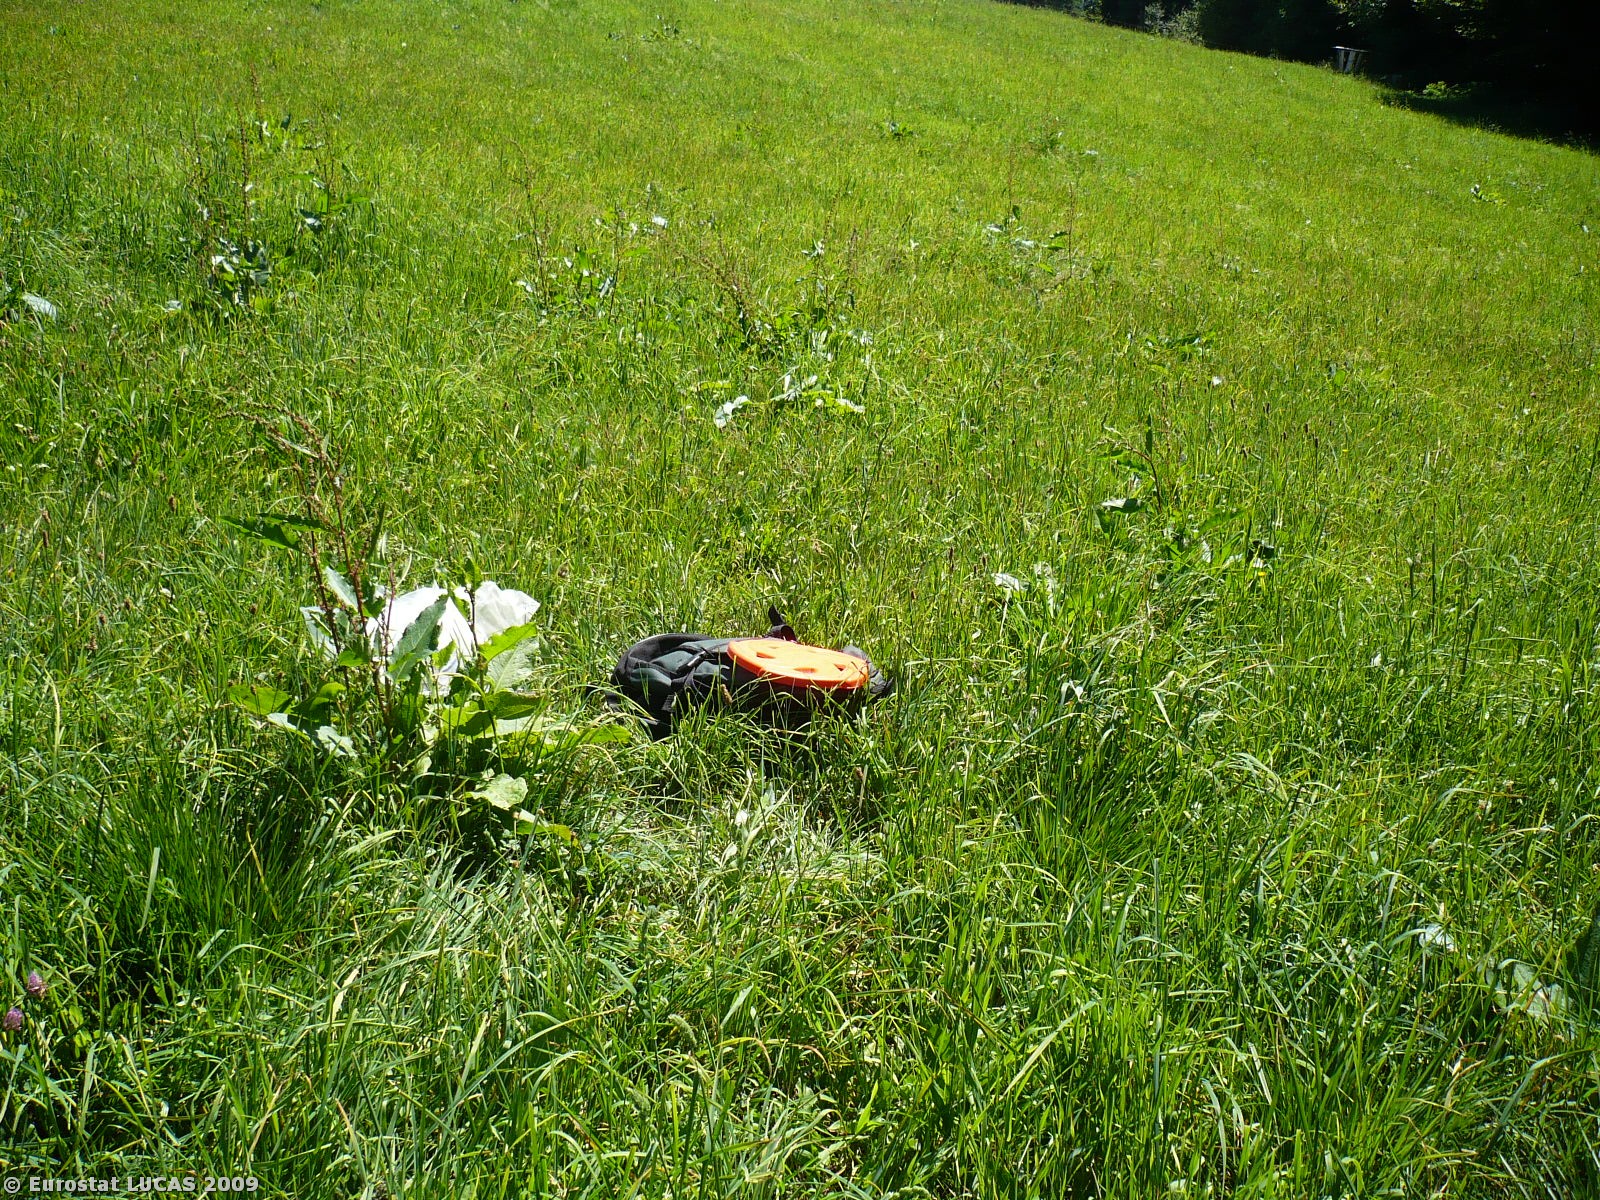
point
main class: Grassland
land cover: Grassland without tree/shrub cover
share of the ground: > 75 %
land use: Agriculture (excluding fallow land and kitchen gardens)
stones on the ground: 10 - 25 %
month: July
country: SI
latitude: 46.6508
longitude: 15.3429
